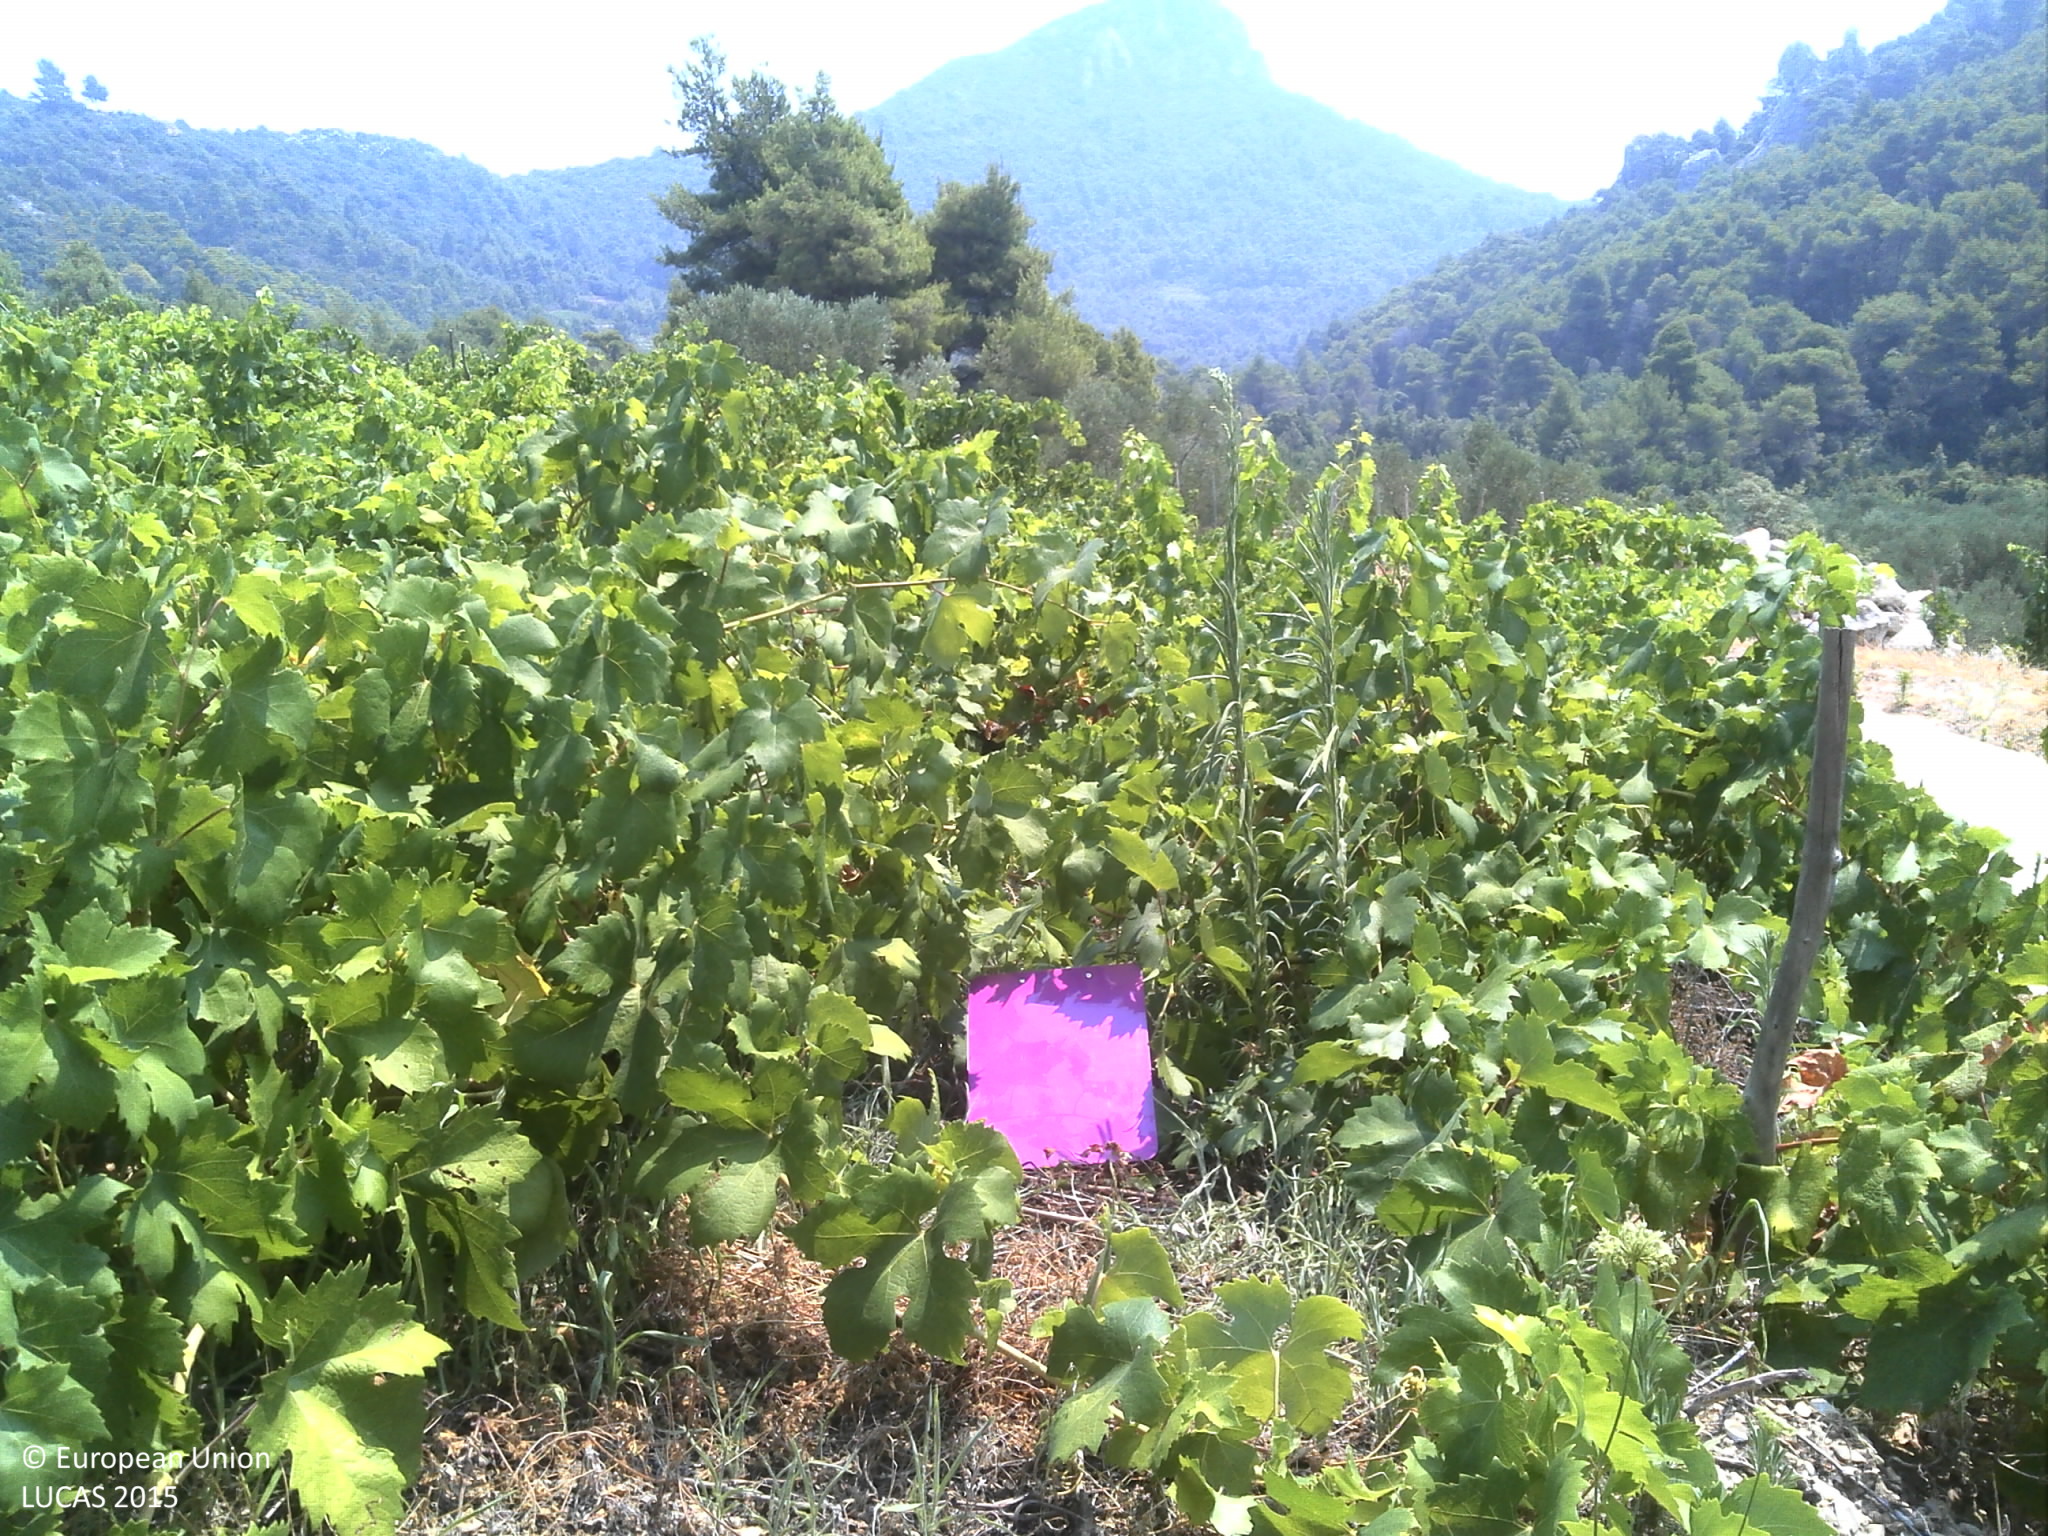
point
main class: Cropland
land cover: Vineyards
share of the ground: > 75 %
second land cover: Grassland without tree/shrub cover
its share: > 75 %
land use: Agriculture (excluding fallow land and kitchen gardens)
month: July
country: HR
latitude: 42.8854
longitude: 17.4709
